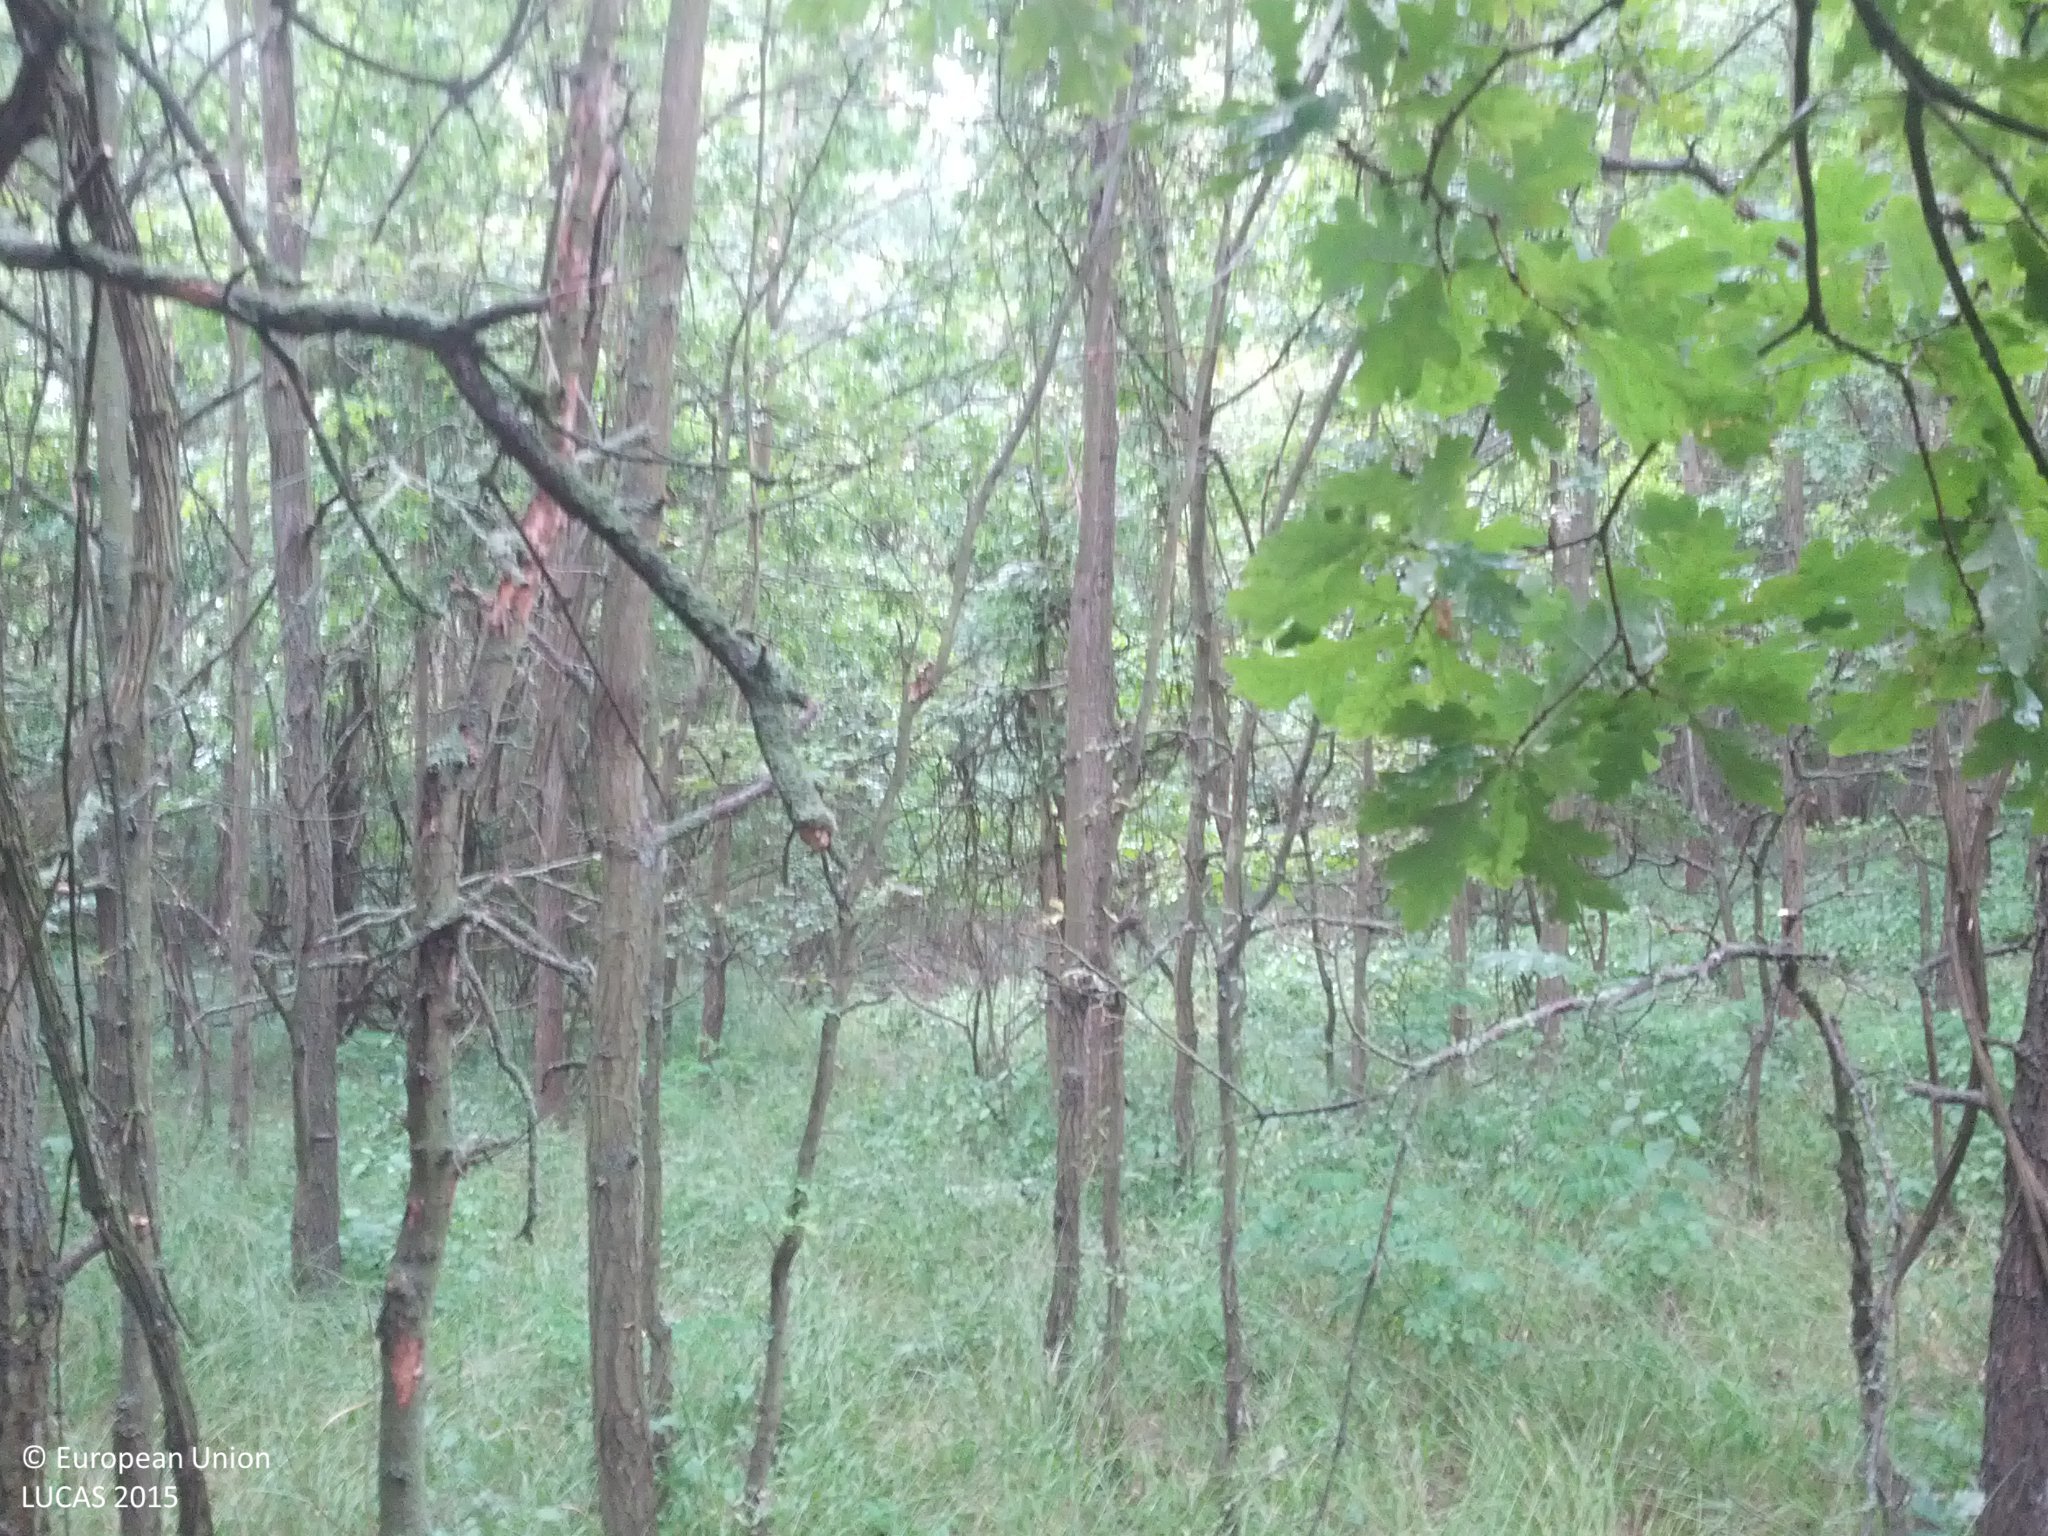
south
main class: Woodland
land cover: Pine dominated mixed woodland
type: hemiboreal forest and nemoral coniferous forest and mixed broadleaved-coniferous forest
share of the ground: > 75 %
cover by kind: coniferous forest trees 65 %, broadleaved forest trees 25 %, herbaceous plants 10 %
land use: Forestry
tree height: > 5 m
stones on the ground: < 10 %
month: July
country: AT
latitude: 48.5754
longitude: 16.1447
